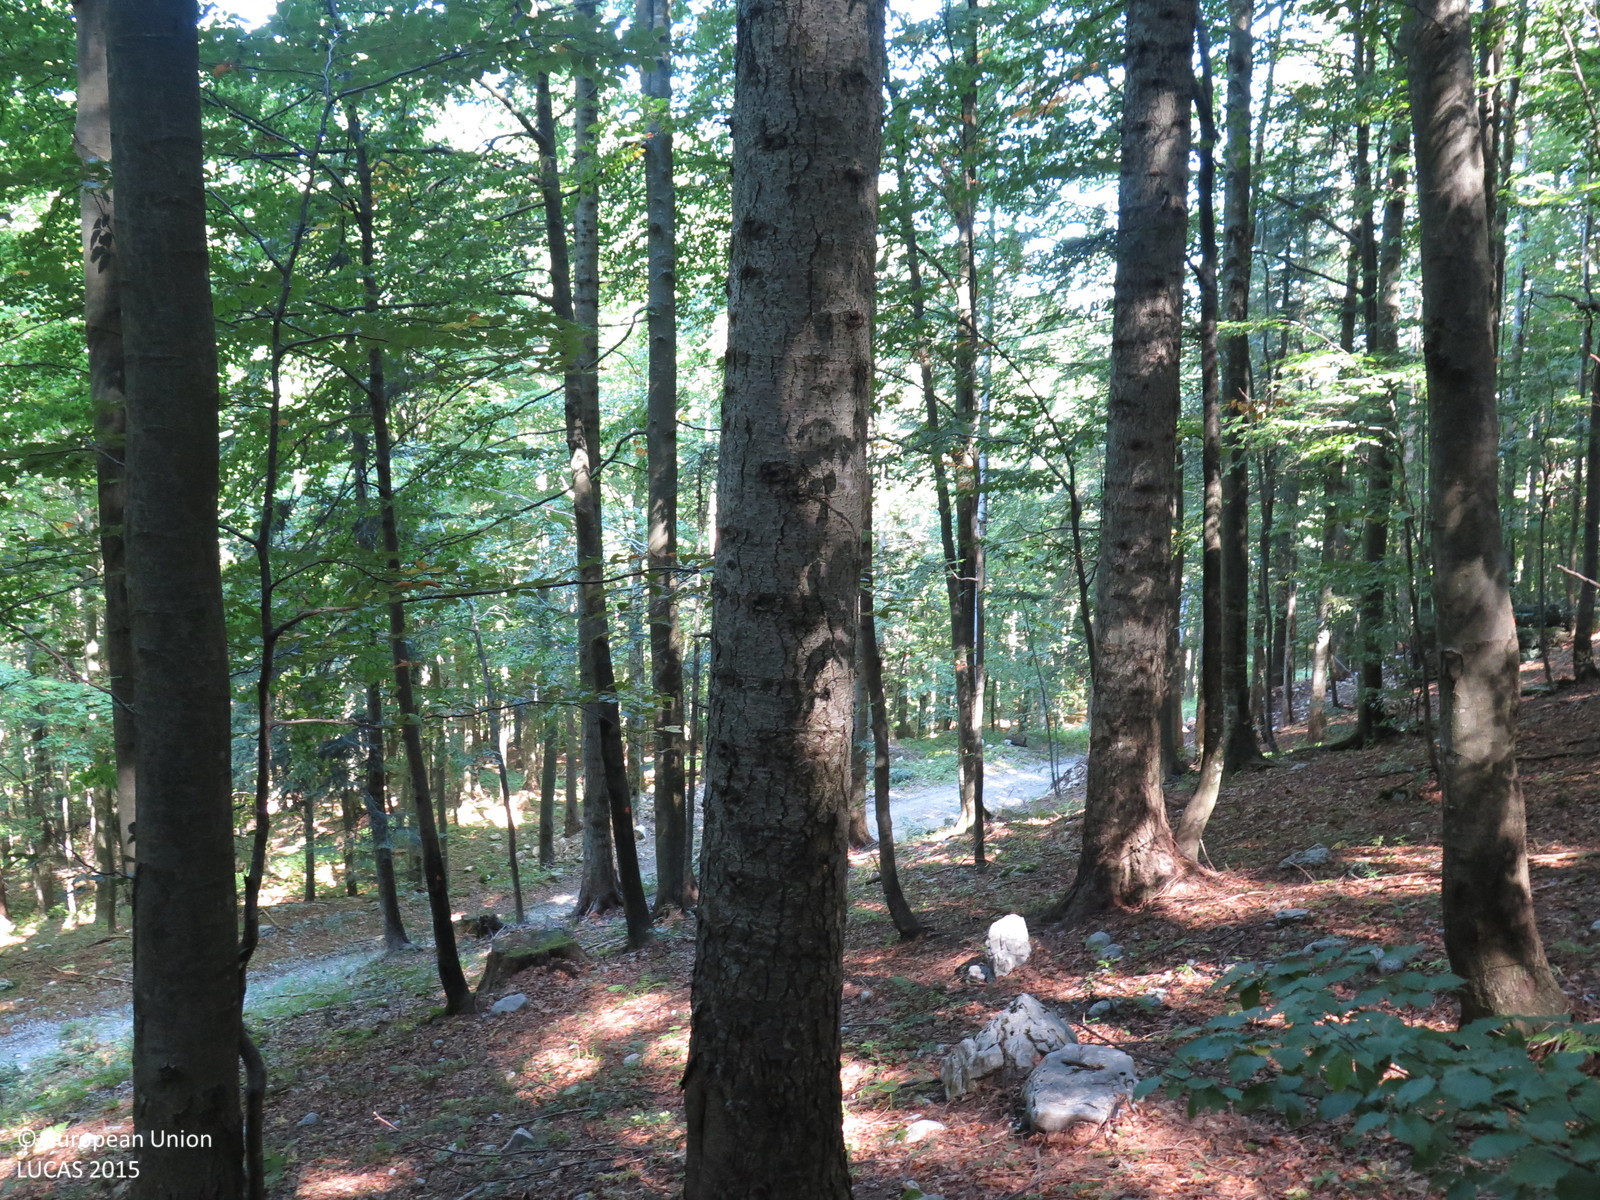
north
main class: Woodland
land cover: Other mixed woodland
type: mountainous beech forest
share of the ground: > 75 %
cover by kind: broadleaved forest trees 75 %, coniferous forest trees 25 %
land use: Forestry
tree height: > 5 m
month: September
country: HR
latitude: 45.5352
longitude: 14.4902
